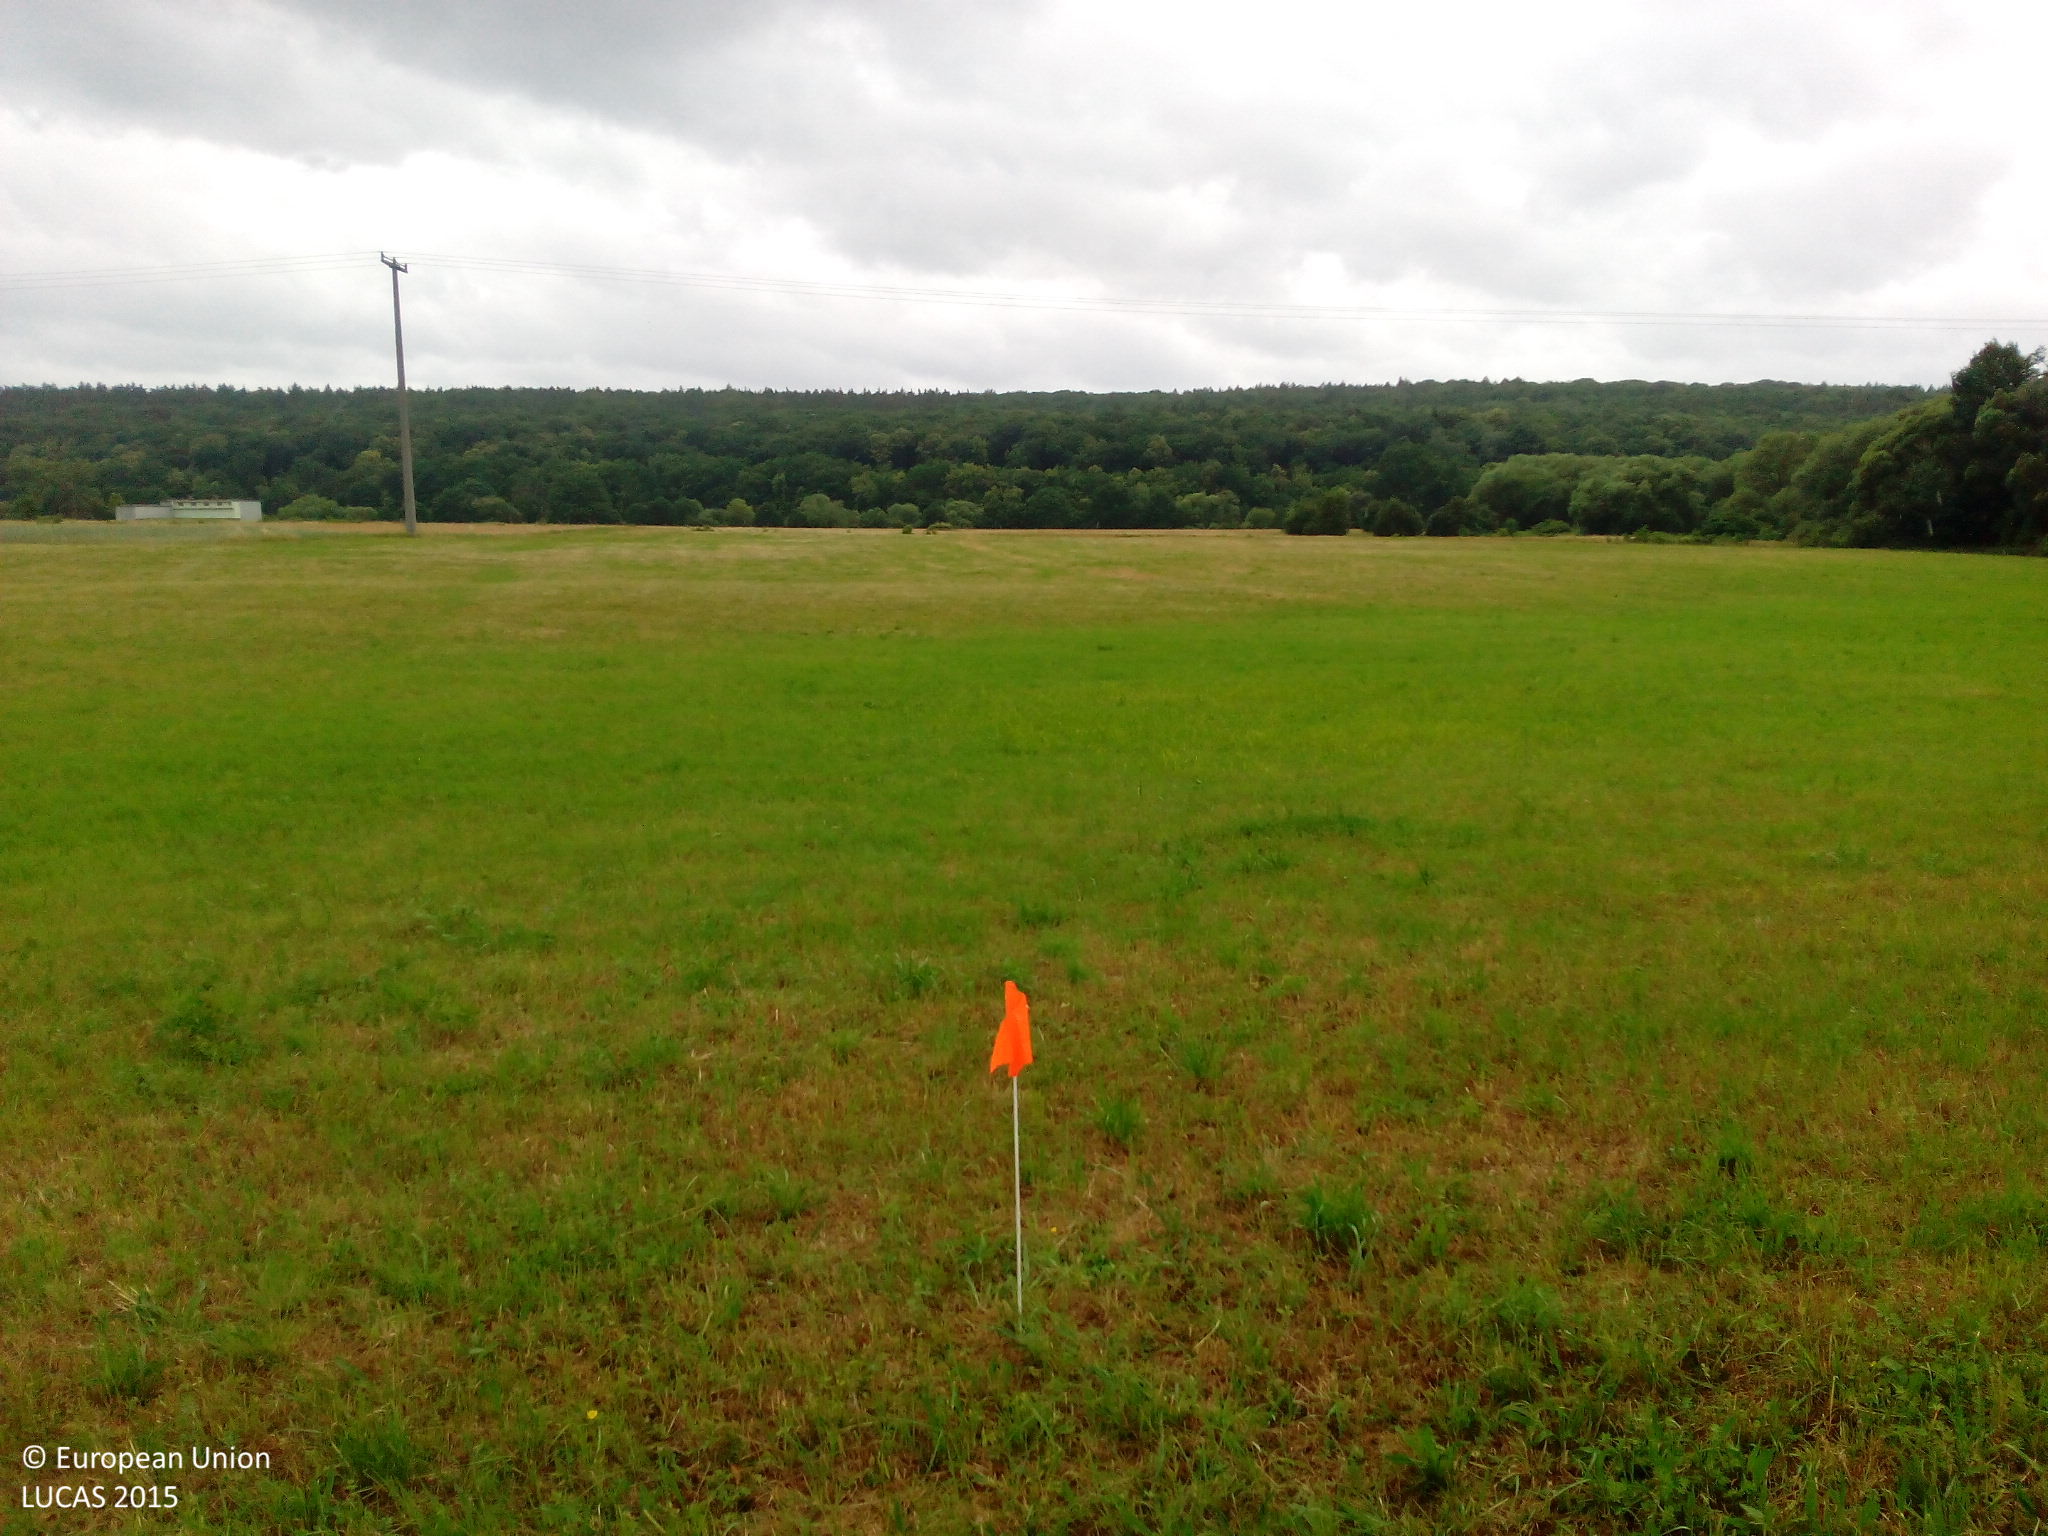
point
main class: Grassland
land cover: Grassland without tree/shrub cover
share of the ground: > 75 %
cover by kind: herbaceous plants 100 %
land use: Agriculture (excluding fallow land and kitchen gardens)
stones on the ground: < 10 %
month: June
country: DE
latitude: 49.8567
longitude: 10.9316
